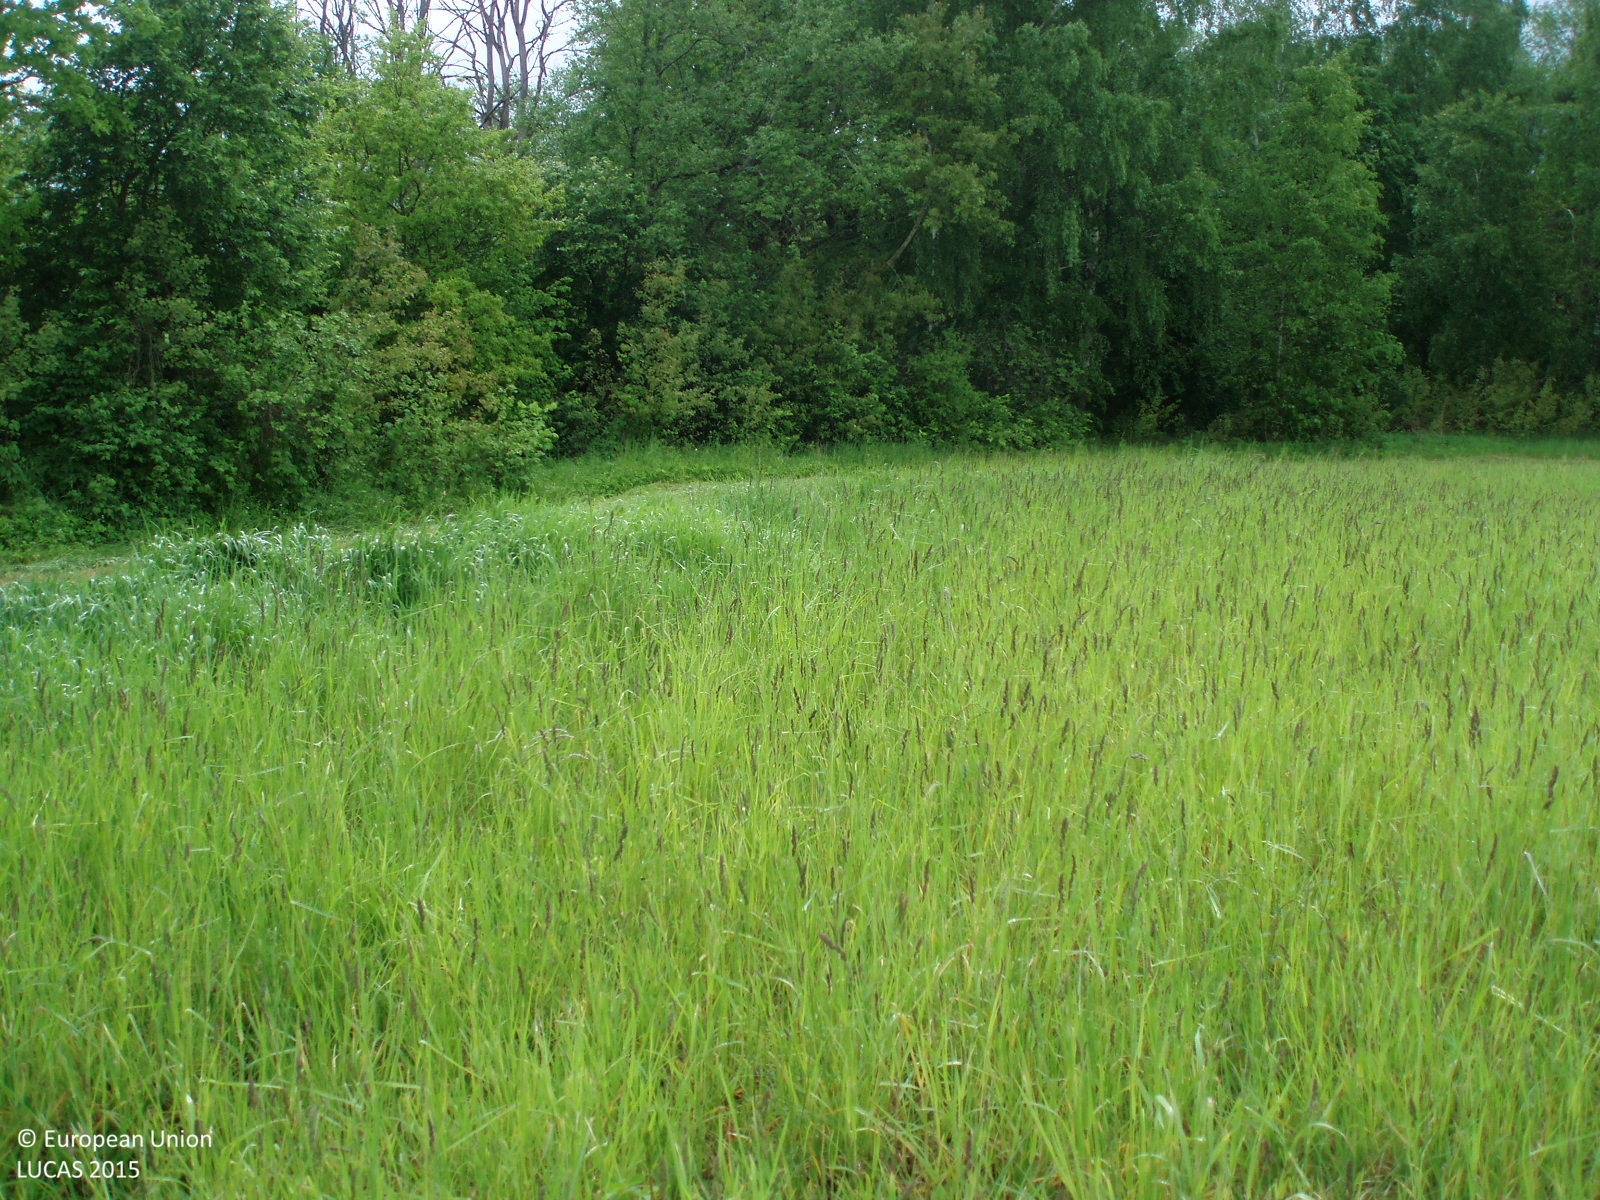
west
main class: Grassland
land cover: Grassland without tree/shrub cover
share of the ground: > 75 %
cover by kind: herbaceous plants 70 %, lichens and mosses 30 %
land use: Agriculture (excluding fallow land and kitchen gardens)
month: May
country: LT
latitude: 56.1531
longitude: 22.5356
